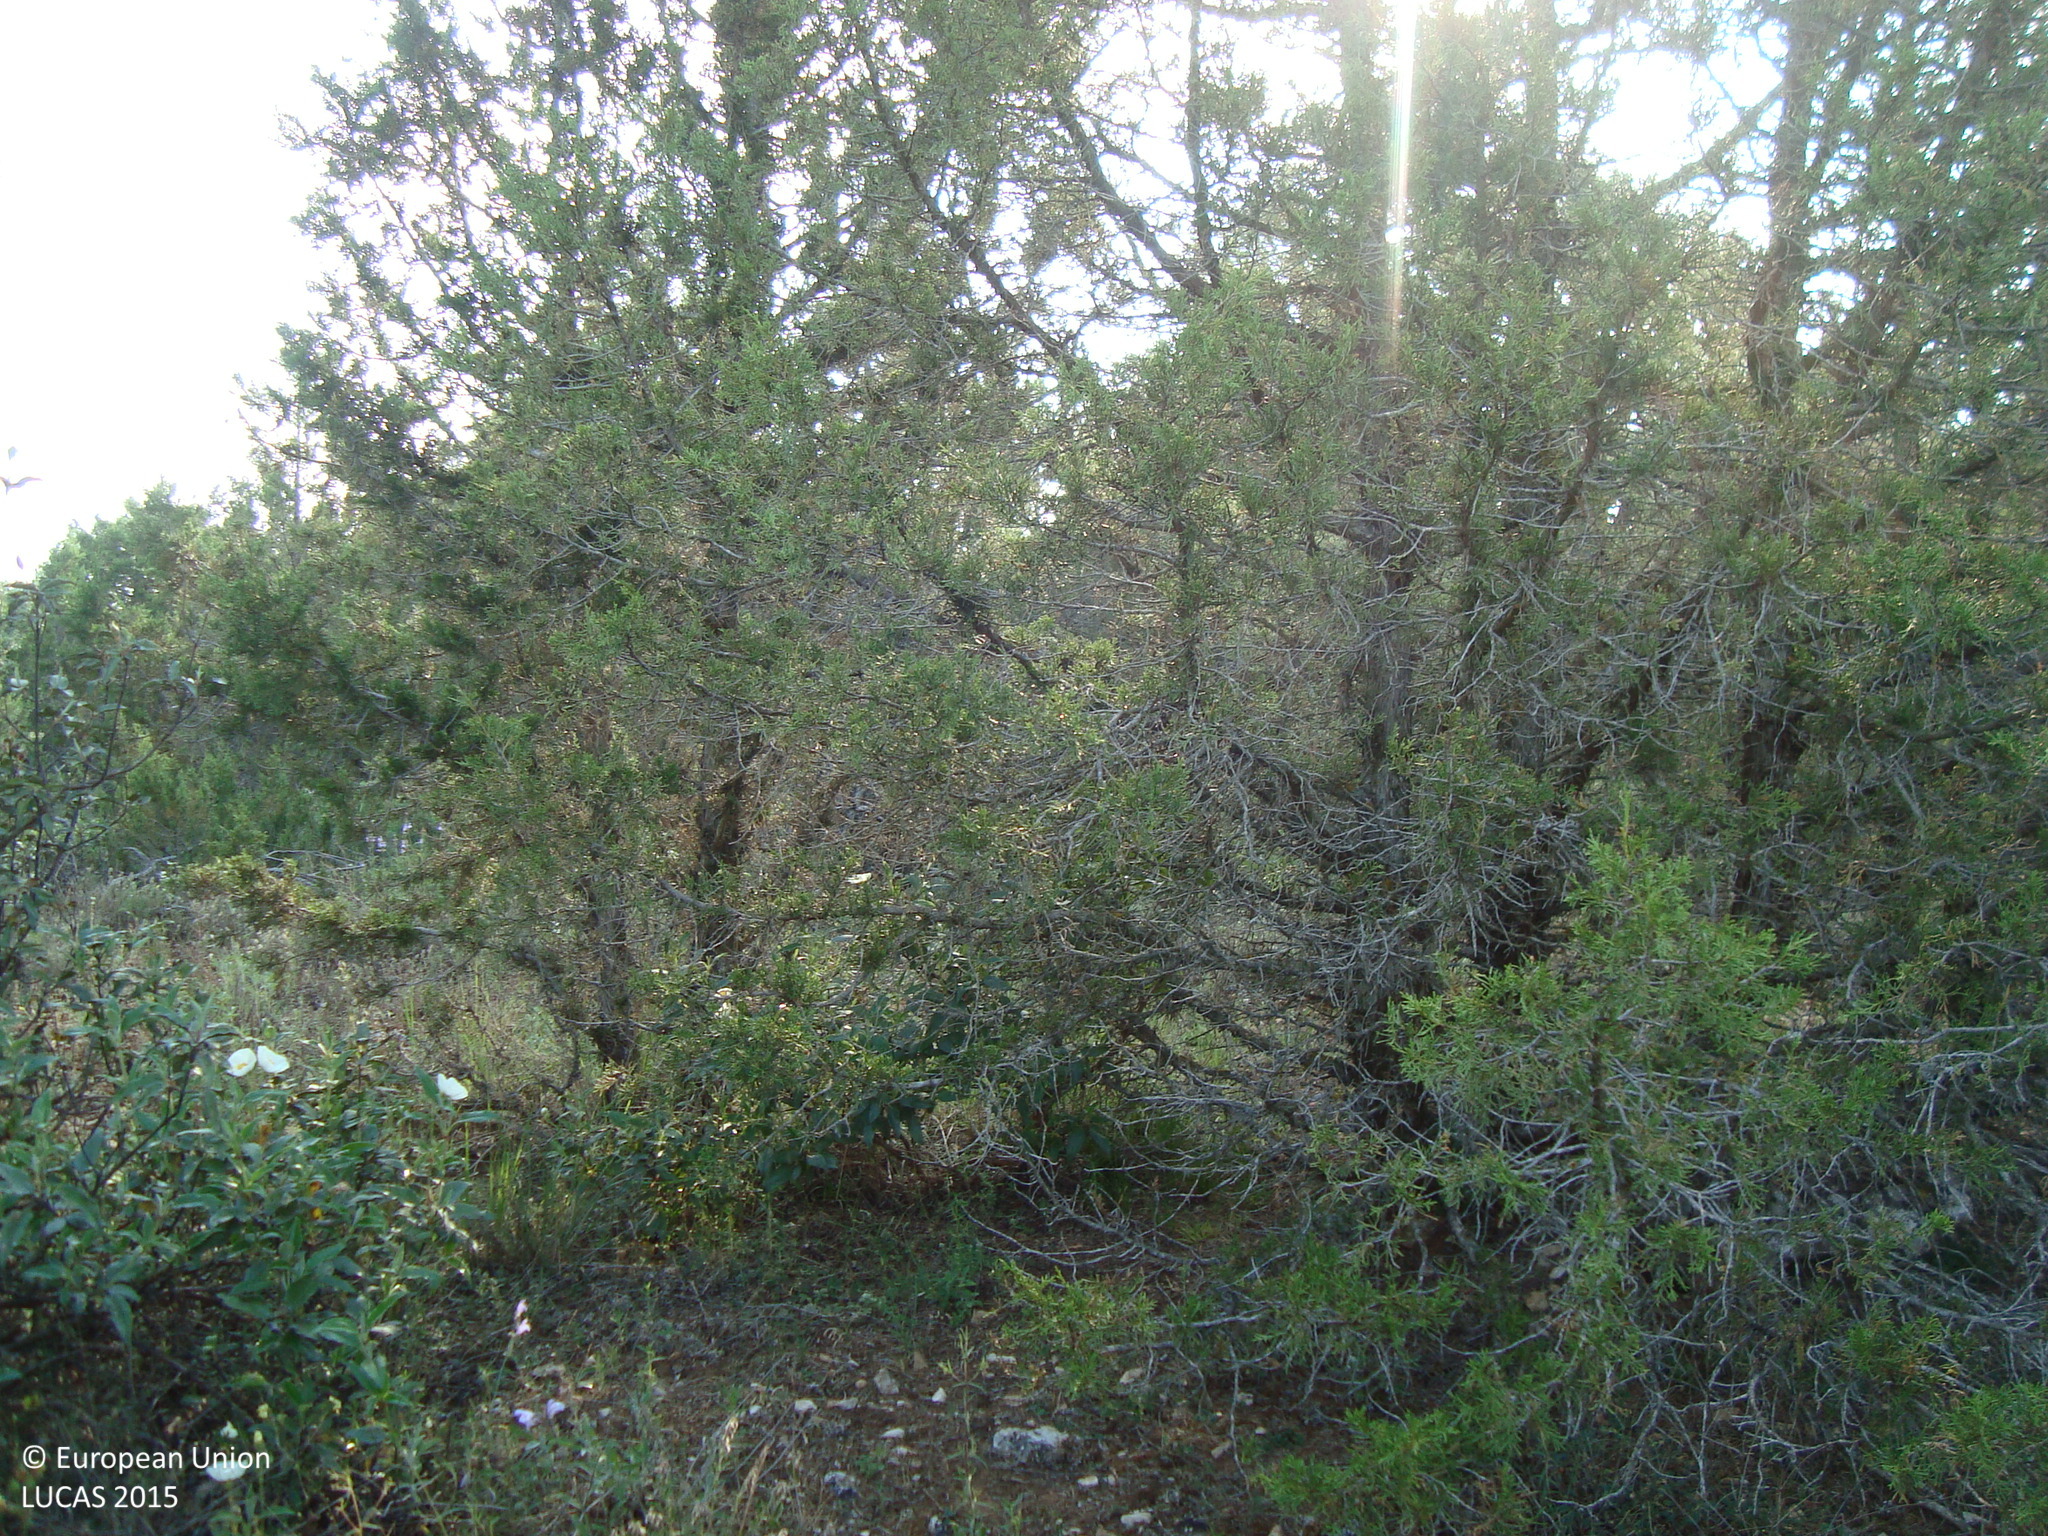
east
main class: Woodland
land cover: Other coniferous woodland
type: coniferous forest of the mediterranean region
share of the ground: 25 - 50 %
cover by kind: coniferous forest trees 40 %, shrubs 40 %, herbaceous plants 10 %, unconsolidated bare surface 10 %
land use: Forestry
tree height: > 5 m
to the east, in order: Other coniferous woodland; Shrubland without tree cover; Barley
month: June
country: ES
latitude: 41.9394
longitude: -3.8198
